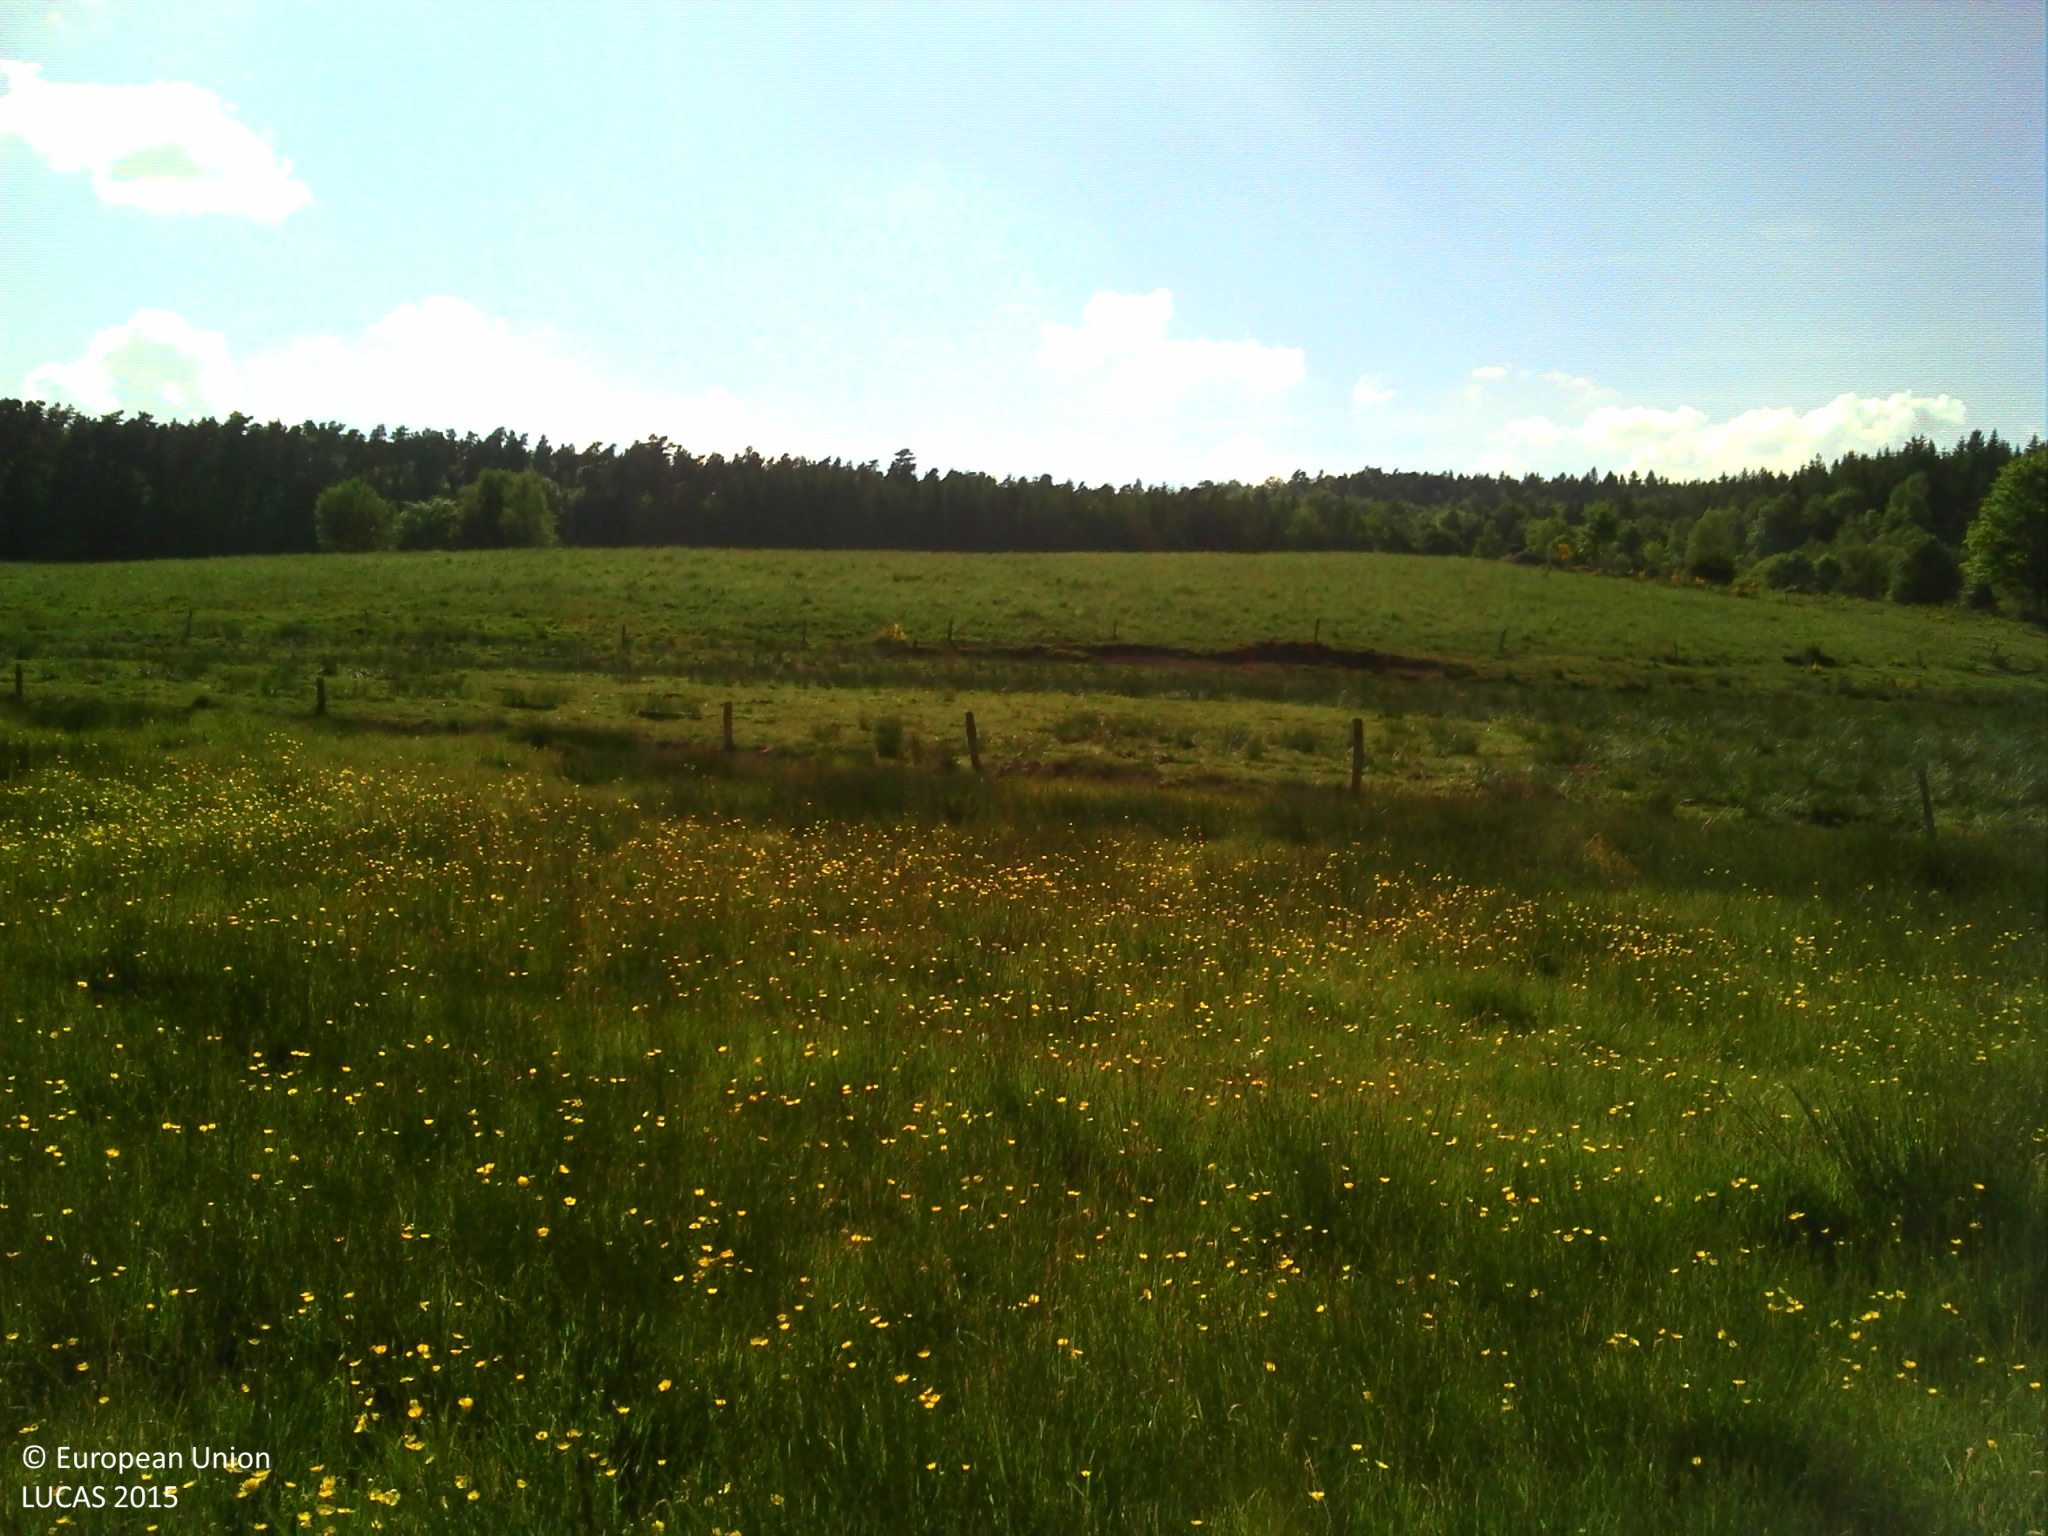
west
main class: Grassland
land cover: Grassland without tree/shrub cover
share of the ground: > 75 %
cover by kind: herbaceous plants 100 %
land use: Agriculture (excluding fallow land and kitchen gardens)
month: June
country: FR
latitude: 44.7794
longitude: 2.9384
